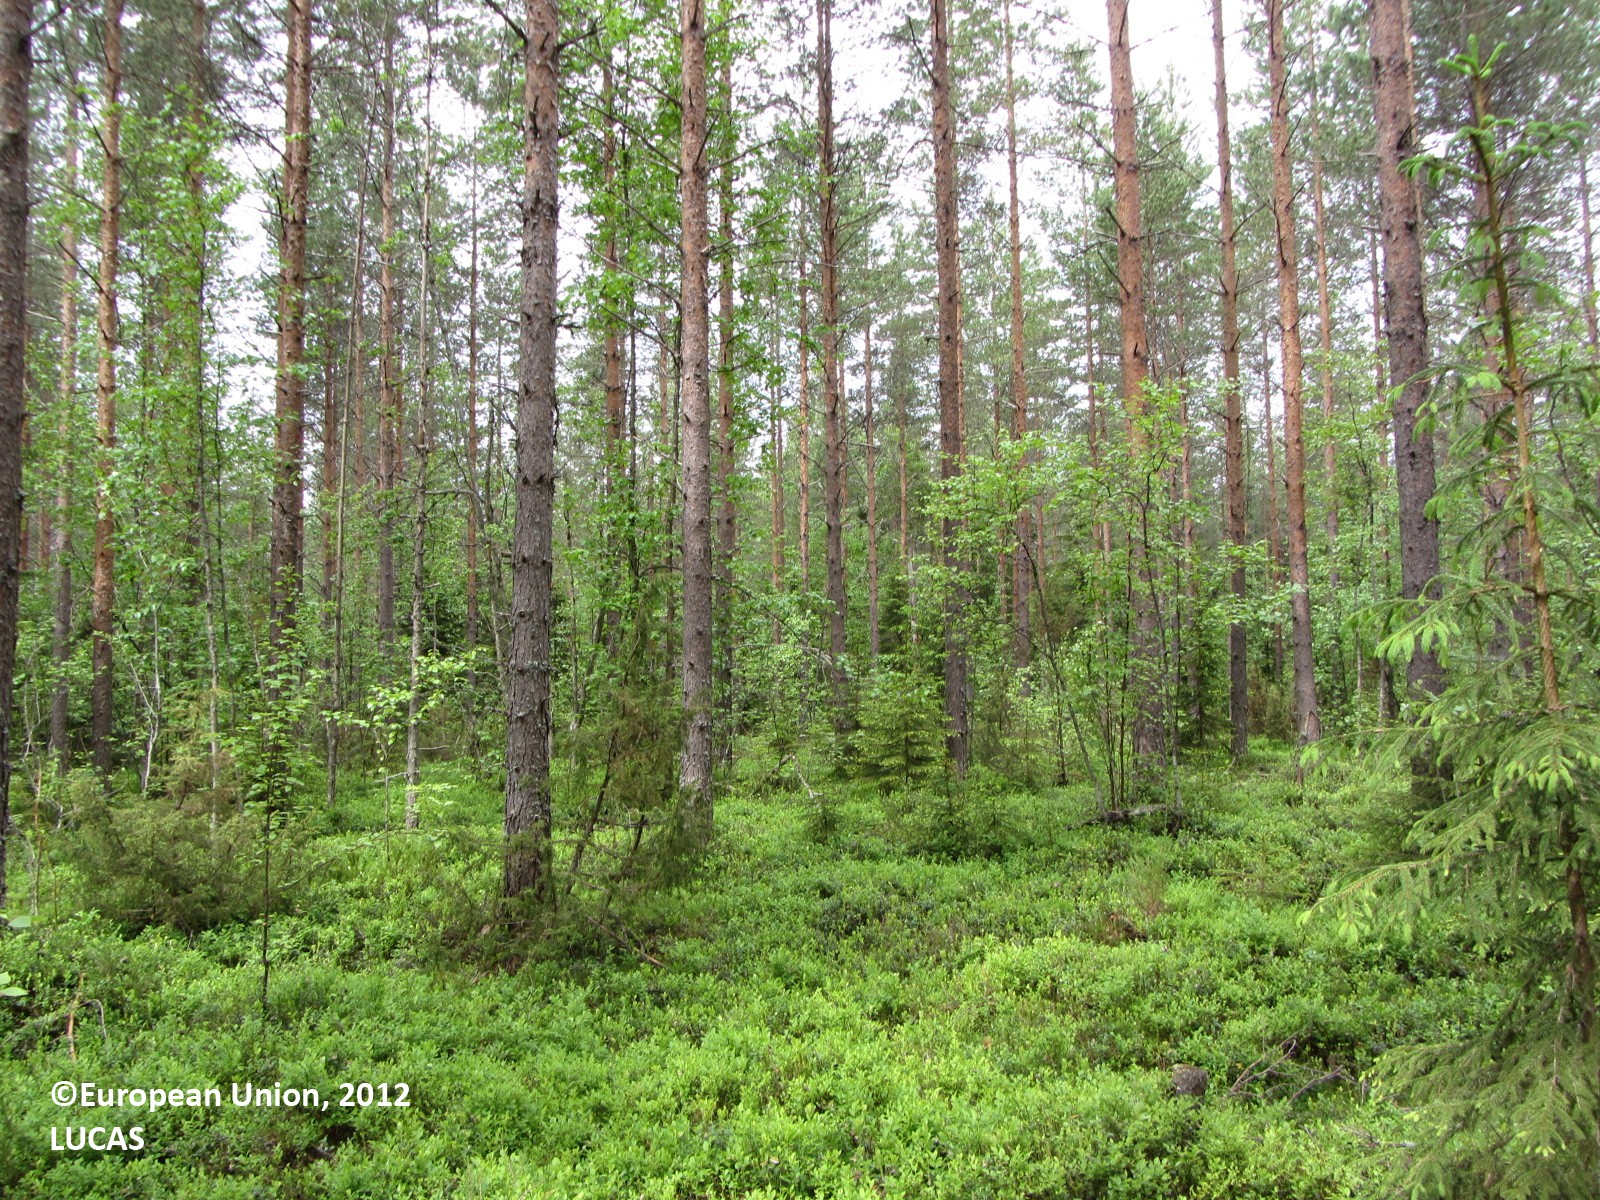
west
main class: Woodland
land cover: Pine dominated coniferous woodland
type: boreal forest
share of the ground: 50 - 75 %
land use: Forestry
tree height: > 5 m
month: June
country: FI
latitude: 62.4987
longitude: 25.1874
